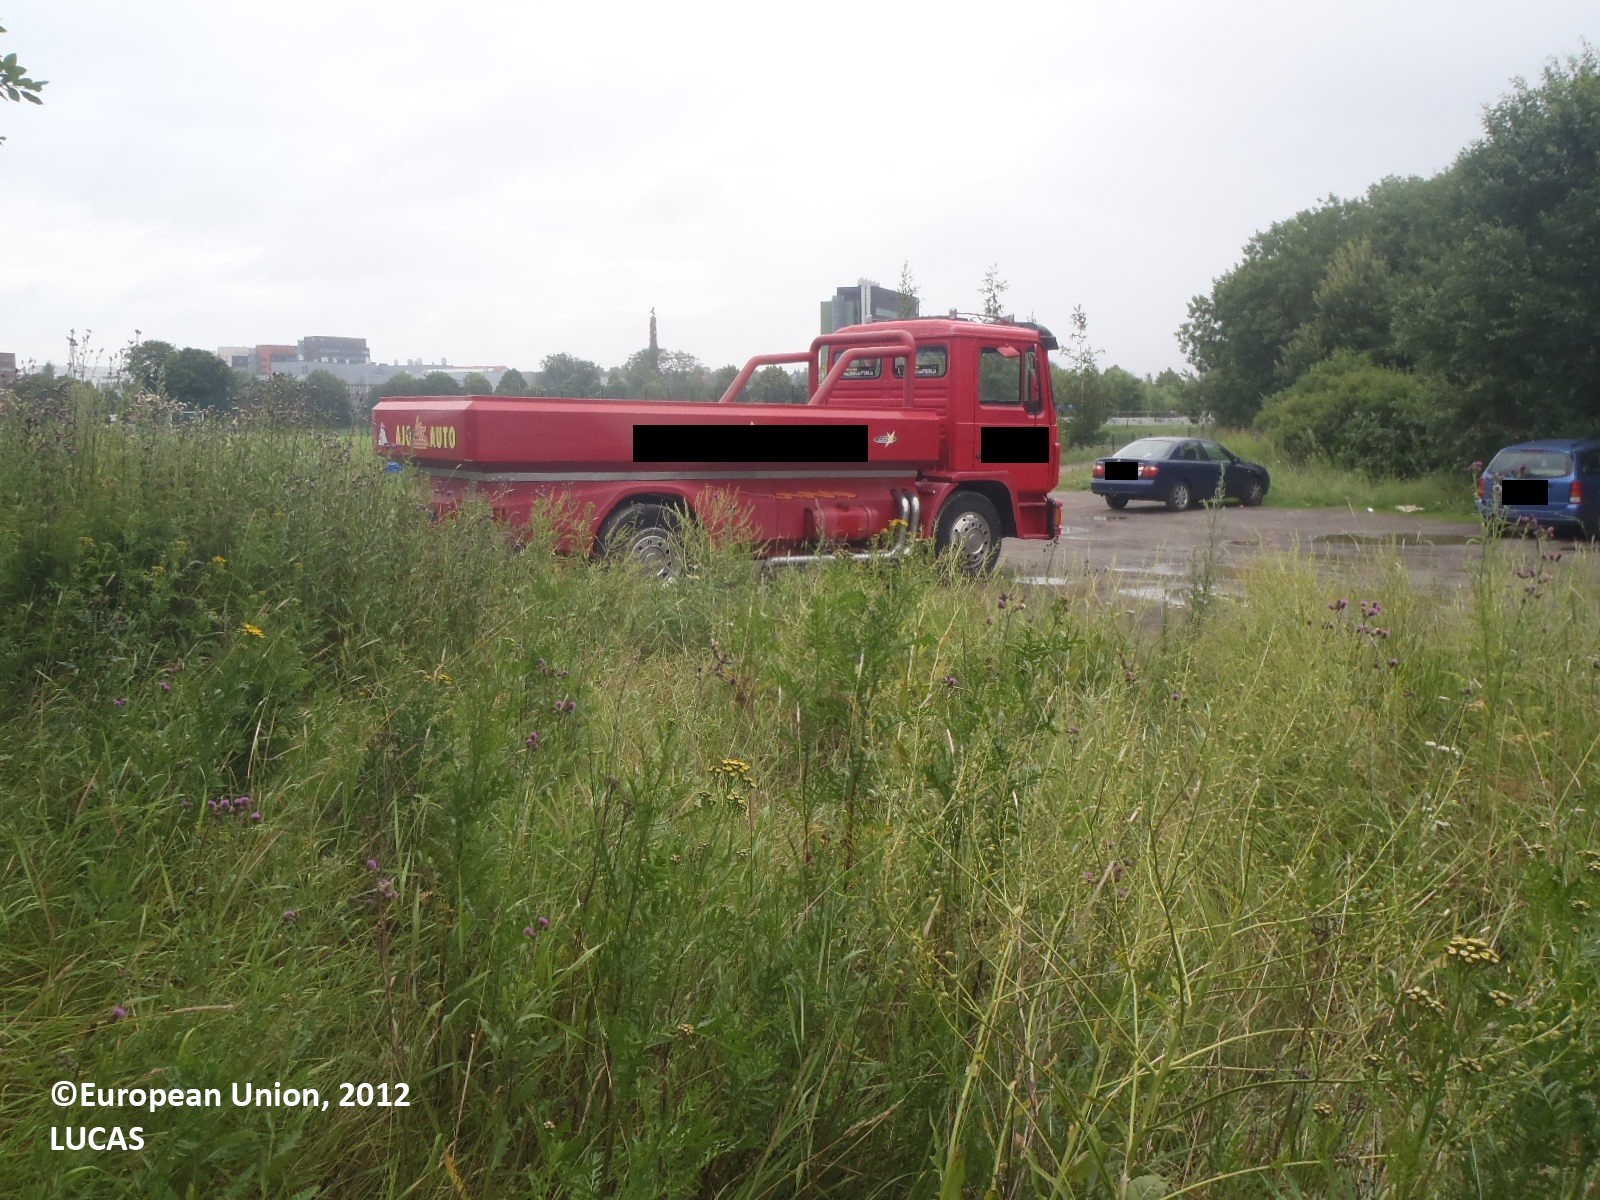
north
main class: Grassland
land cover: Grassland without tree/shrub cover
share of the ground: > 75 %
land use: Abandoned areas
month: July
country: FI
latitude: 60.4432
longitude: 22.2985
